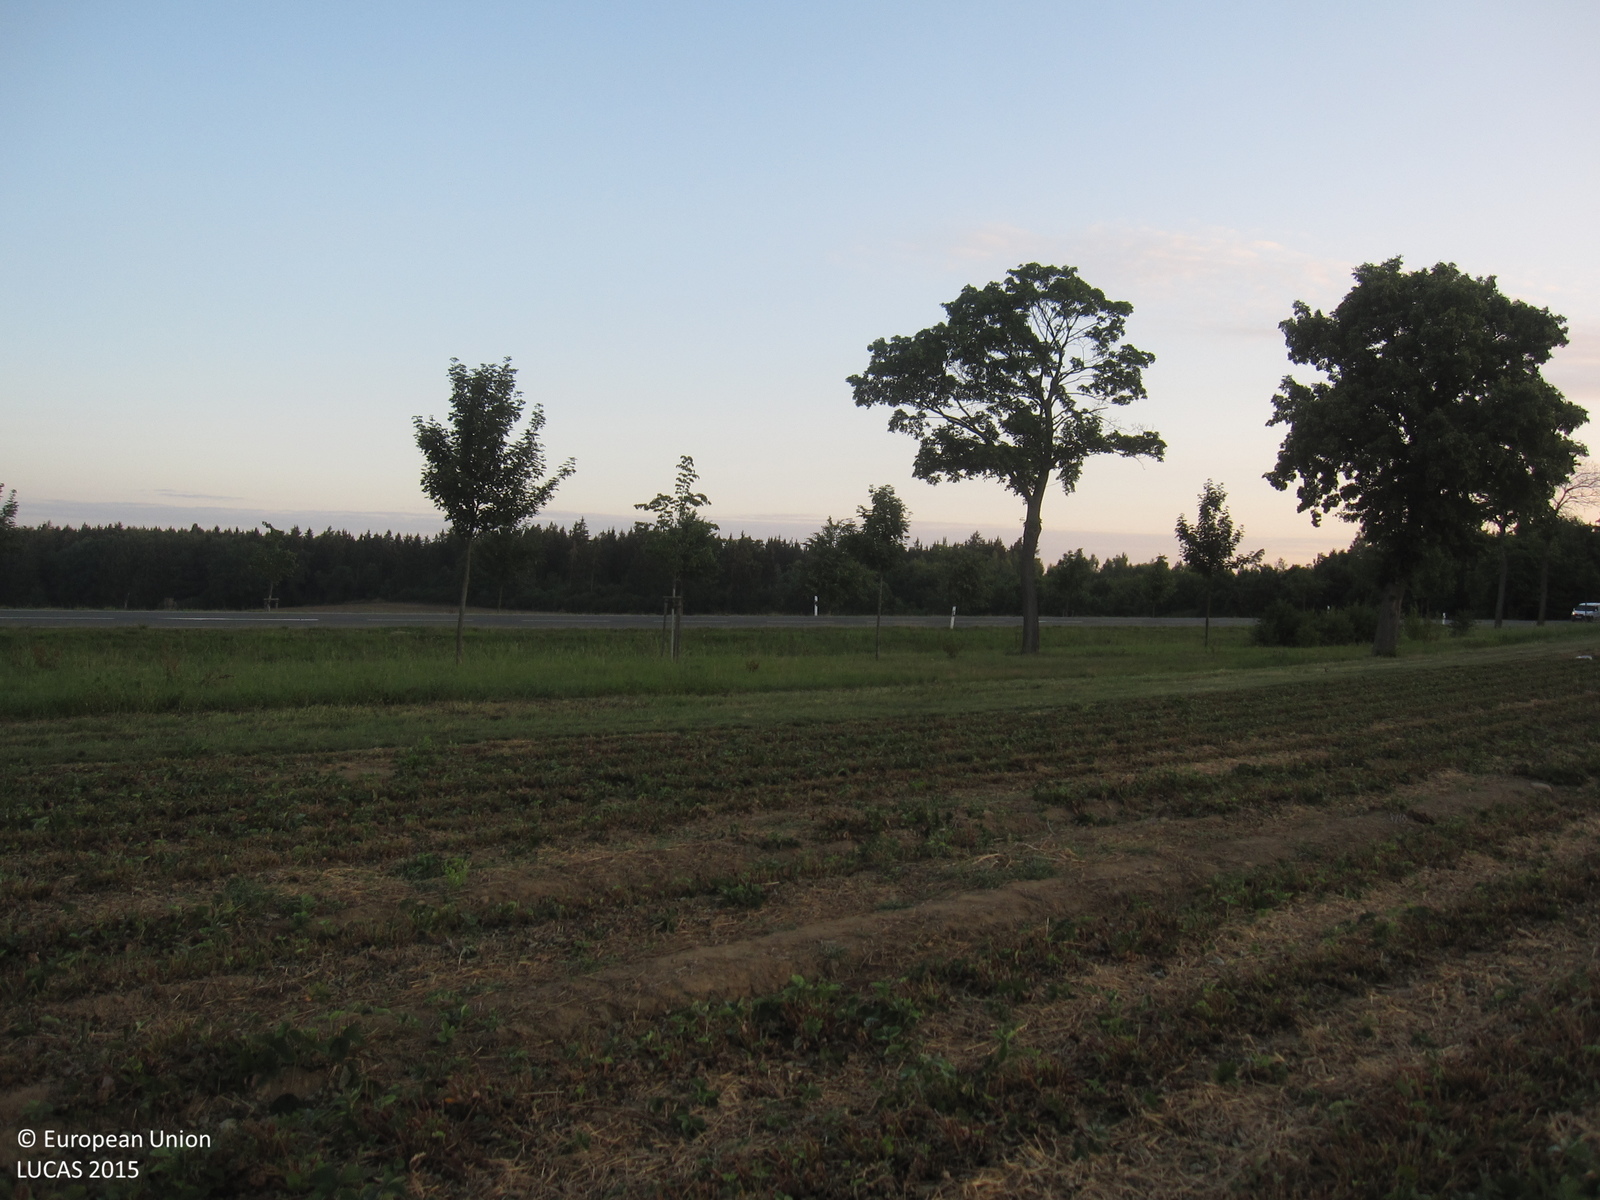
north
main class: Cropland
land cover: Strawberries
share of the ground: 50 - 75 %
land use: Agriculture (excluding fallow land and kitchen gardens)
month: July
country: DE
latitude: 50.4528
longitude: 12.0982
